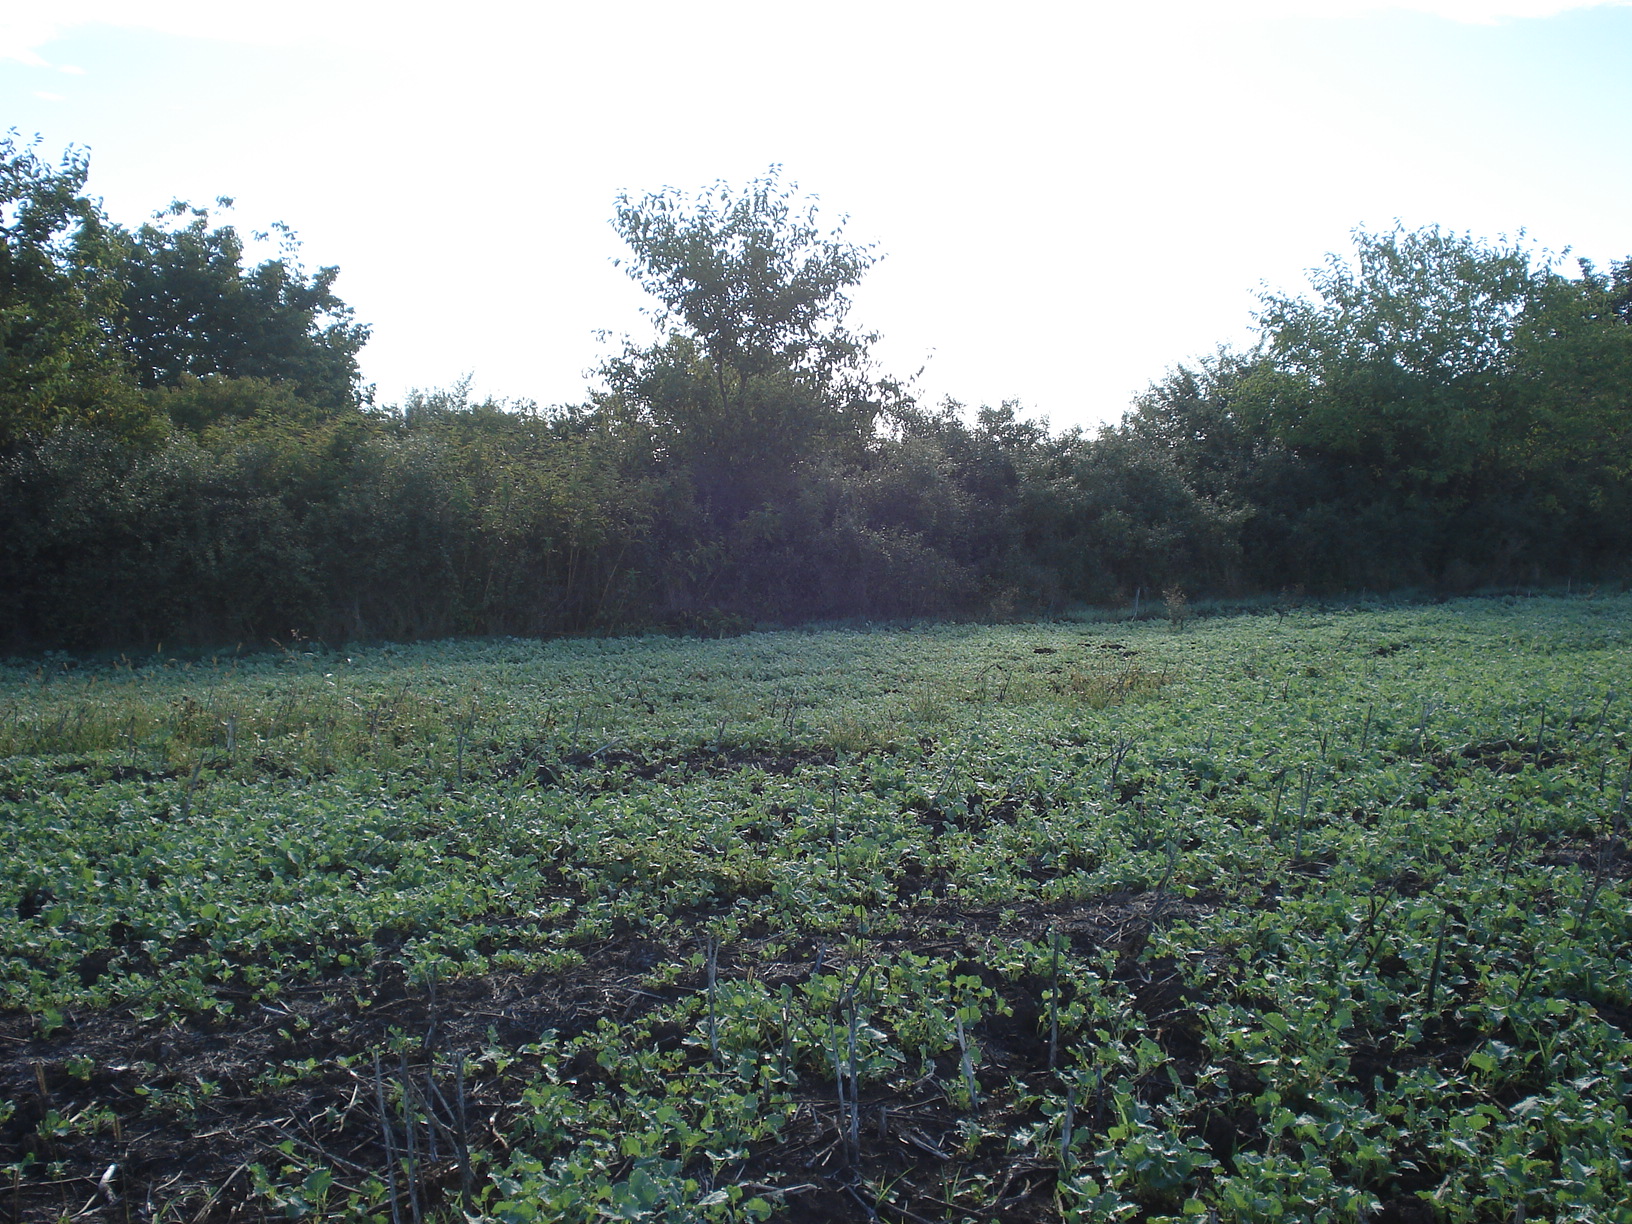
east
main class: Grassland
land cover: Spontaneously vegetated surfaces
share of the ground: > 75 %
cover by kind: herbaceous plants 80 %, unconsolidated bare surface 20 %
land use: Agriculture (excluding fallow land and kitchen gardens)
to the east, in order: Spontaneously vegetated surfaces; Broadleaved woodland; Inland fresh running water; Broadleaved woodland; Other bare soil
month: September
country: BG
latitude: 43.2505
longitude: 25.2605
